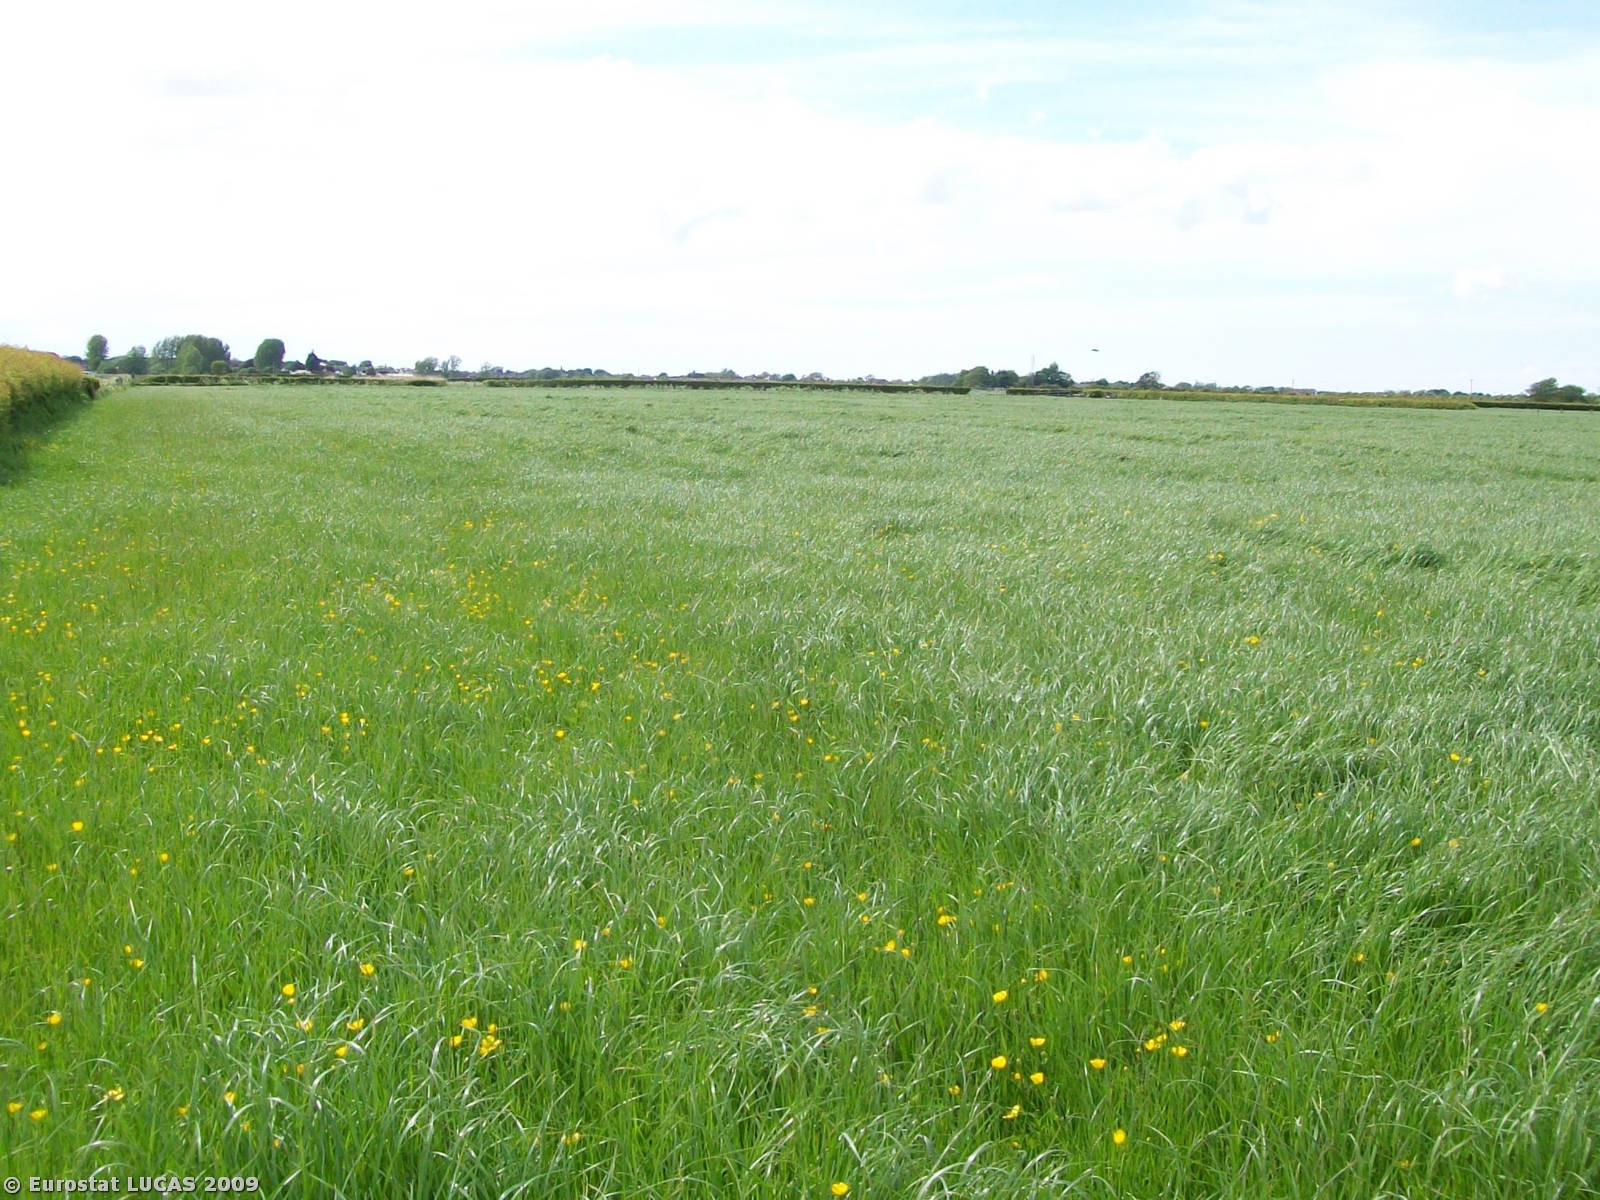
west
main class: Grassland
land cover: Grassland without tree/shrub cover
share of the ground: 25 - 50 %
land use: Agriculture (excluding fallow land and kitchen gardens)
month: May
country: GB
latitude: 53.9247
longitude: -2.9403
